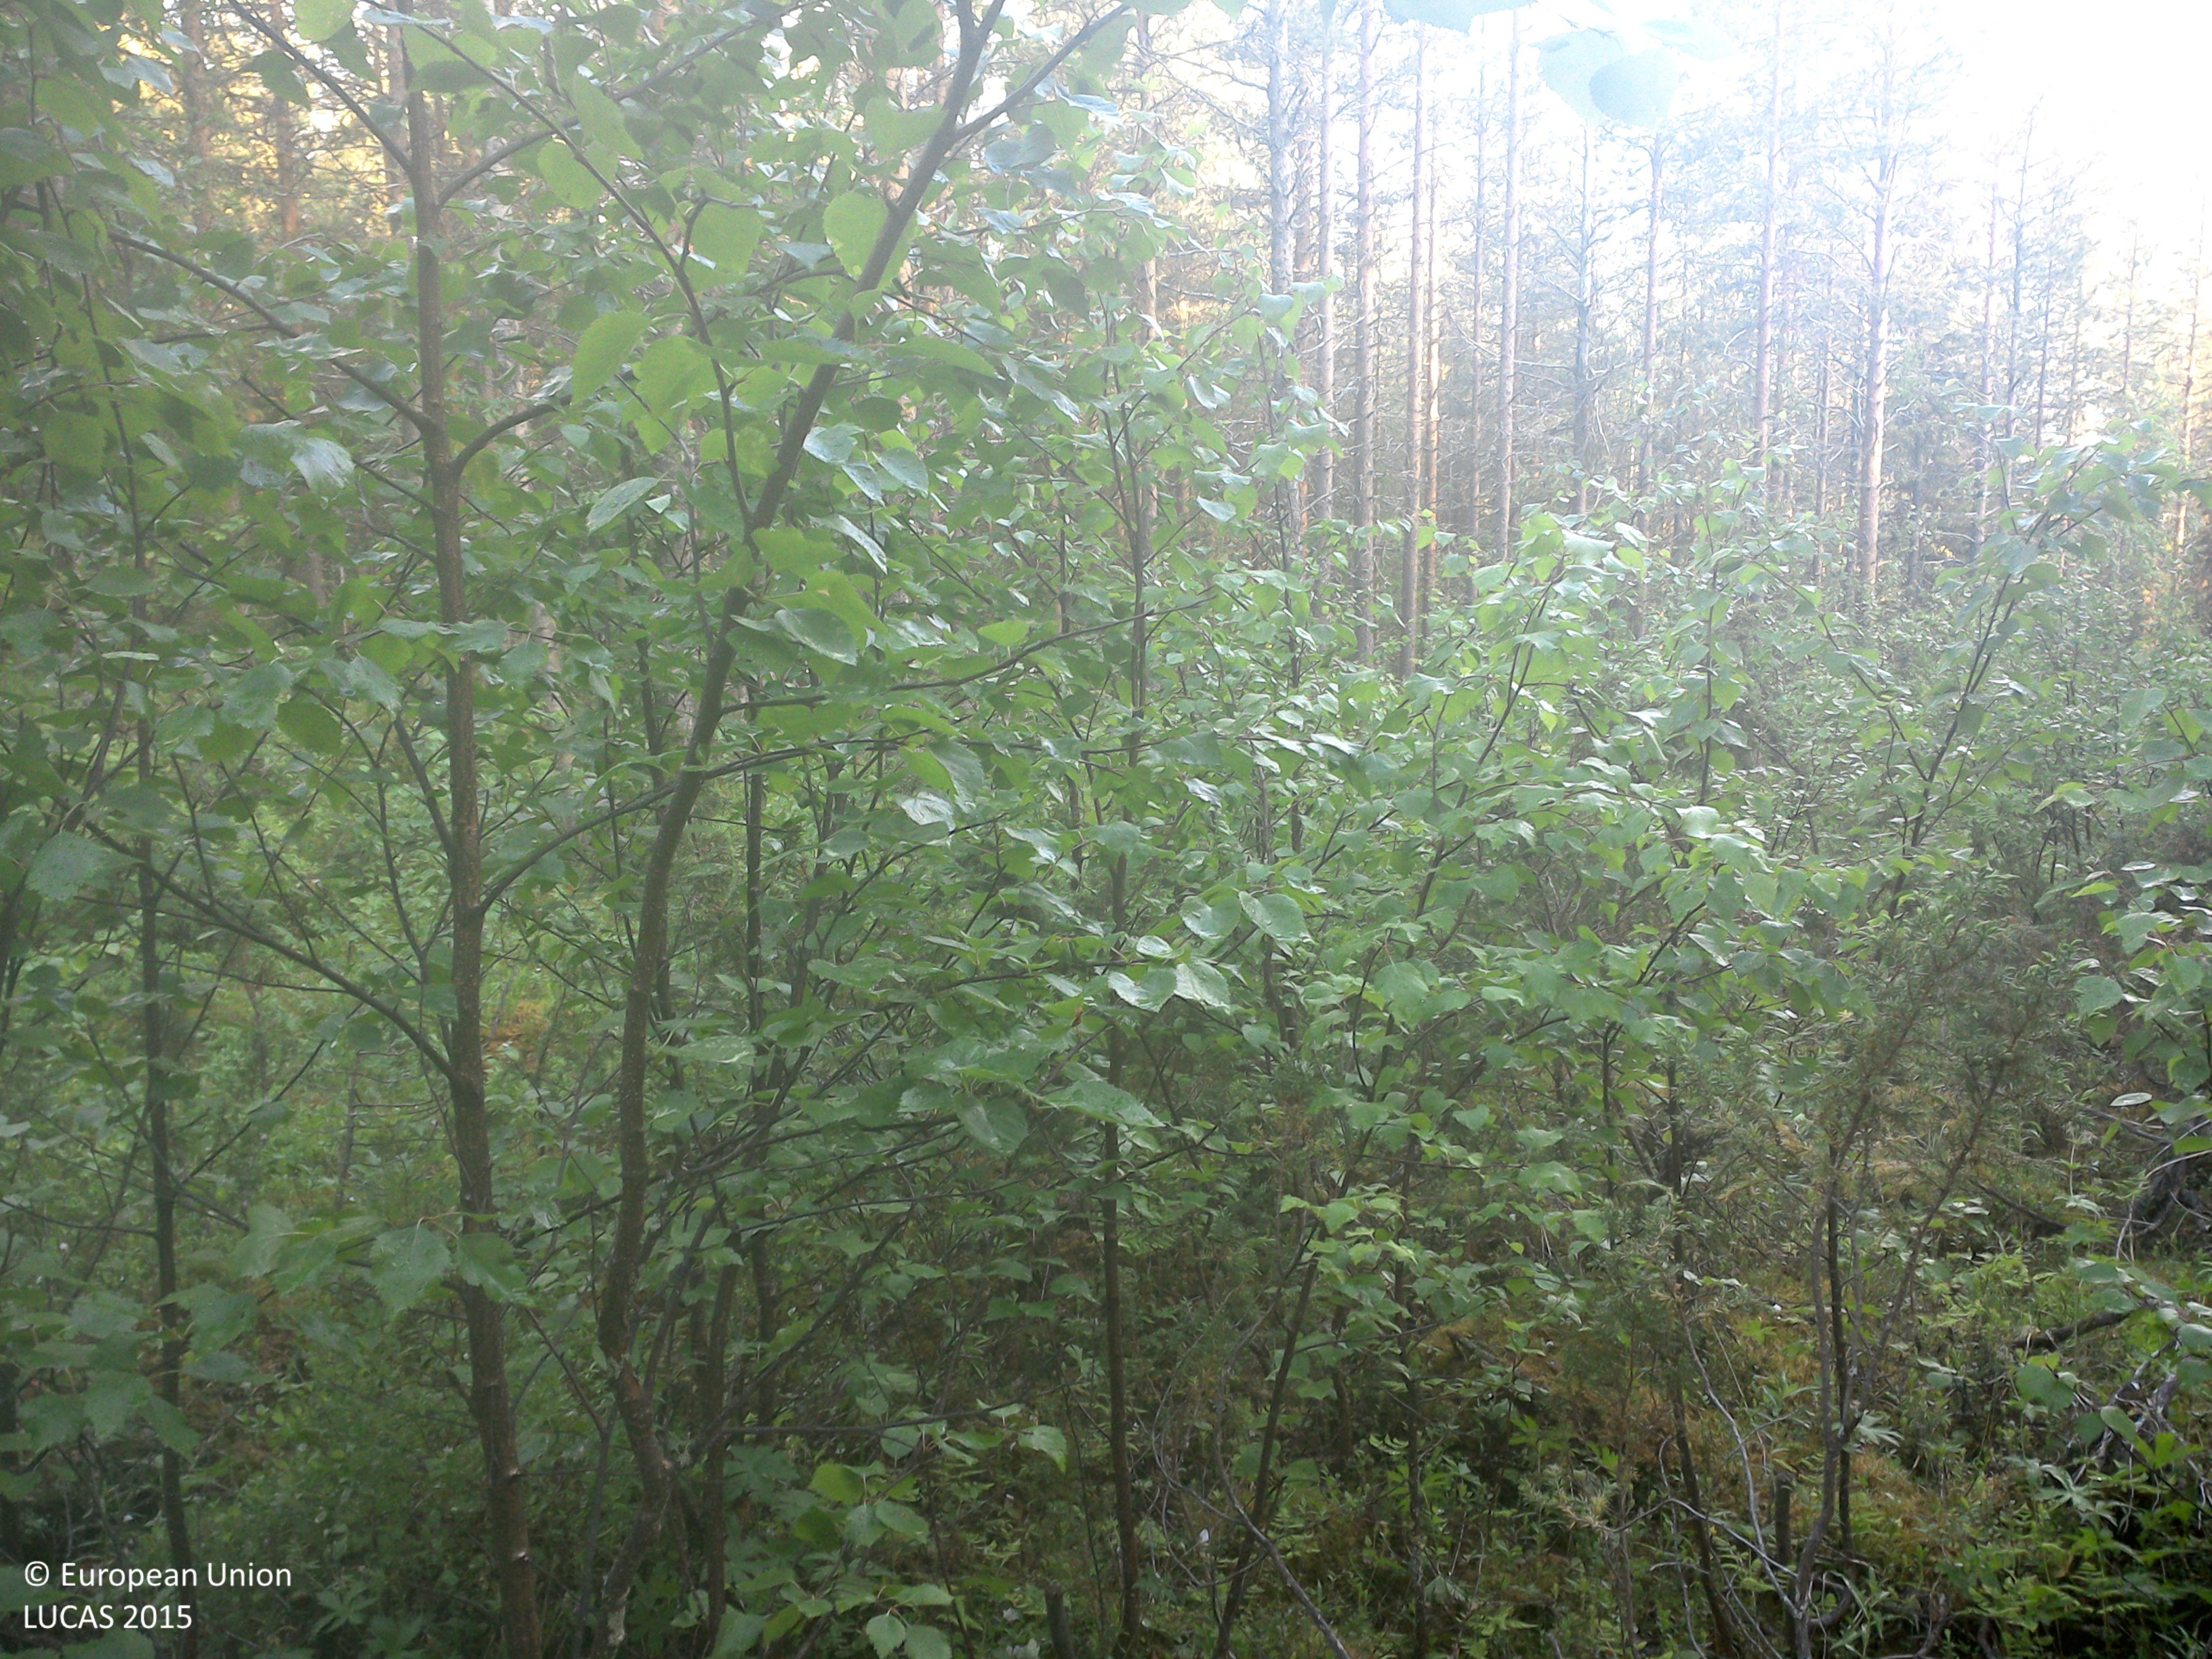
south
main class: Woodland
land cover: Pine dominated mixed woodland
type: boreal forest
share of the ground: 25 - 50 %
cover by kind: shrubs 60 %, coniferous forest trees 20 %, broadleaved forest trees 10 %, herbaceous plants 5 %, lichens and mosses 5 %
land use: Forestry
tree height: > 5 m
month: July
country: SE
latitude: 66.9184
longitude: 23.1626
